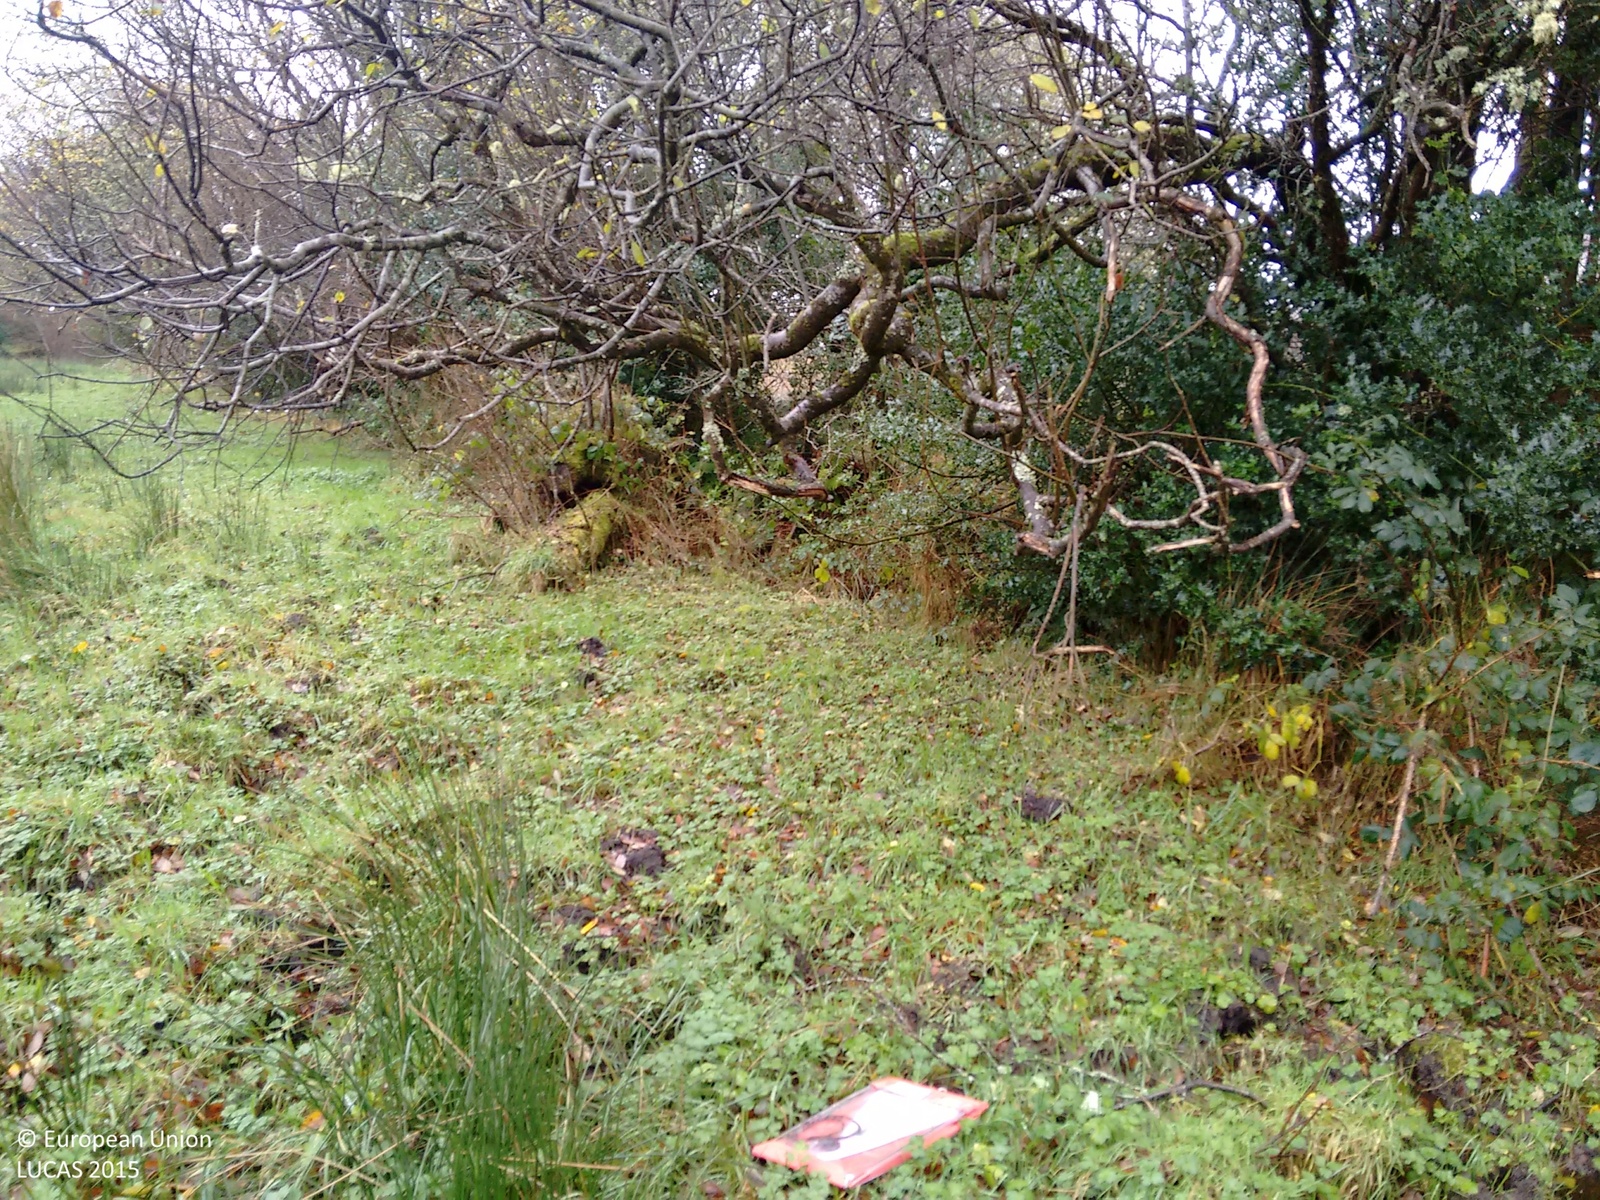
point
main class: Grassland
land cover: Grassland without tree/shrub cover
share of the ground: > 75 %
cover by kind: herbaceous plants 100 %
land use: Agriculture (excluding fallow land and kitchen gardens)
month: November
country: IE
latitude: 54.3693
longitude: -8.0773
